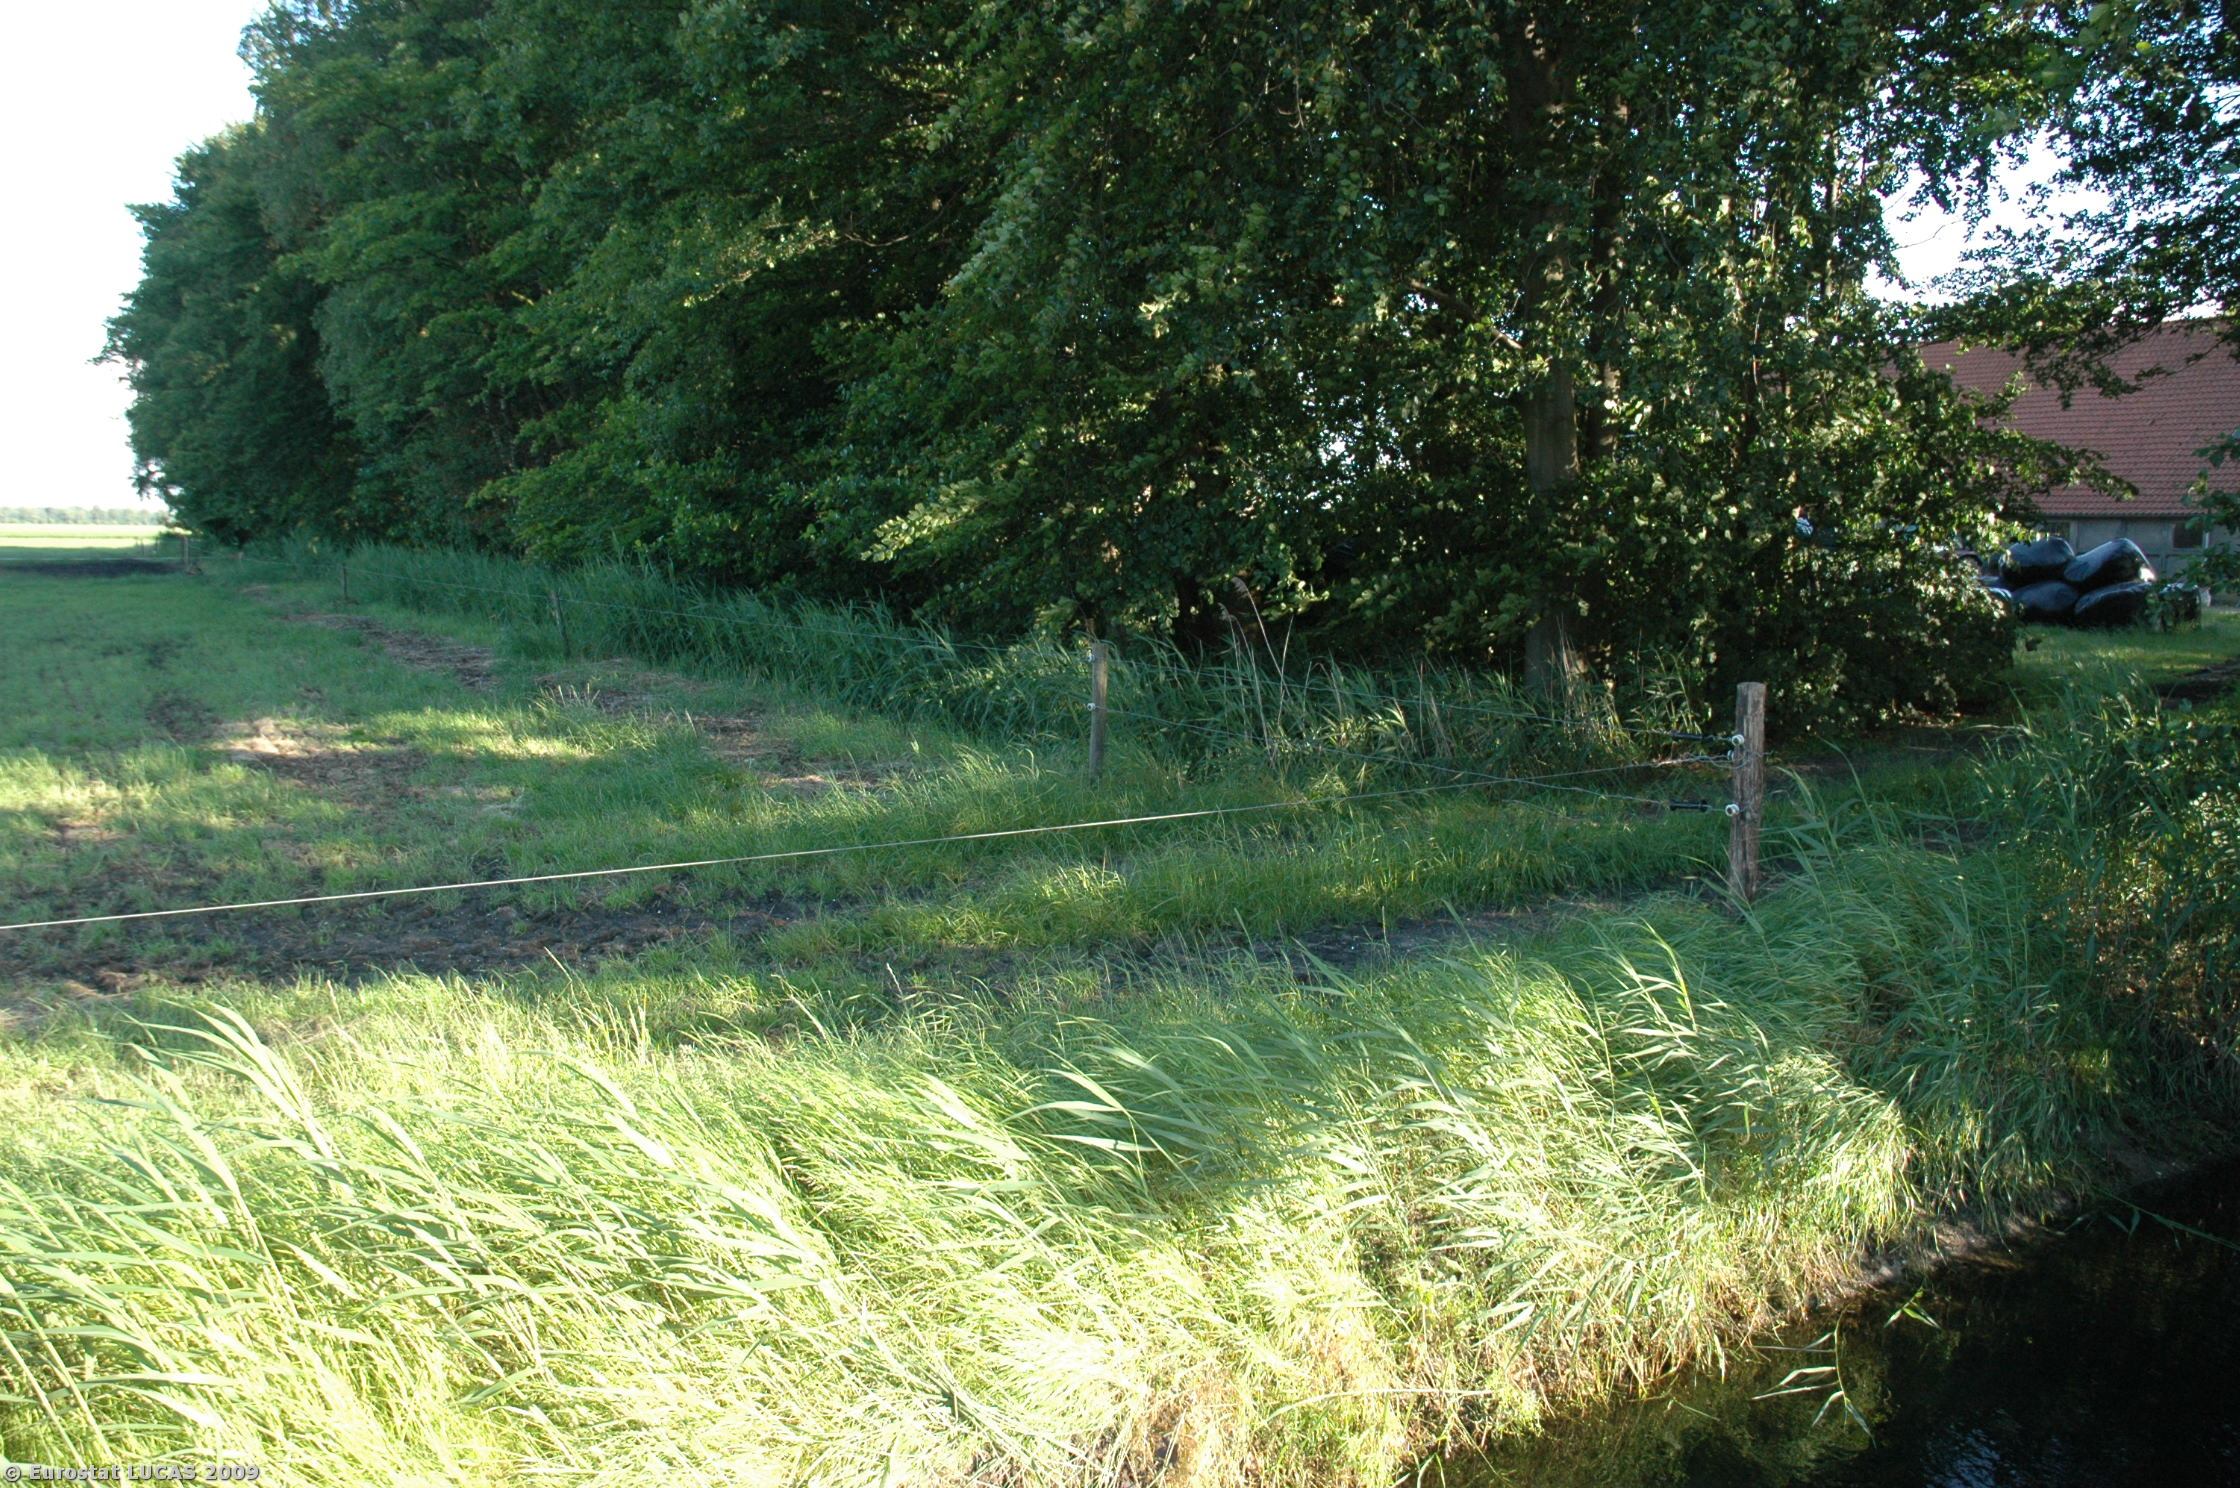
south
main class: Grassland
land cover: Grassland without tree/shrub cover
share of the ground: > 75 %
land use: Agriculture (excluding fallow land and kitchen gardens)
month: June
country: NL
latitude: 52.6753
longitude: 5.6358
